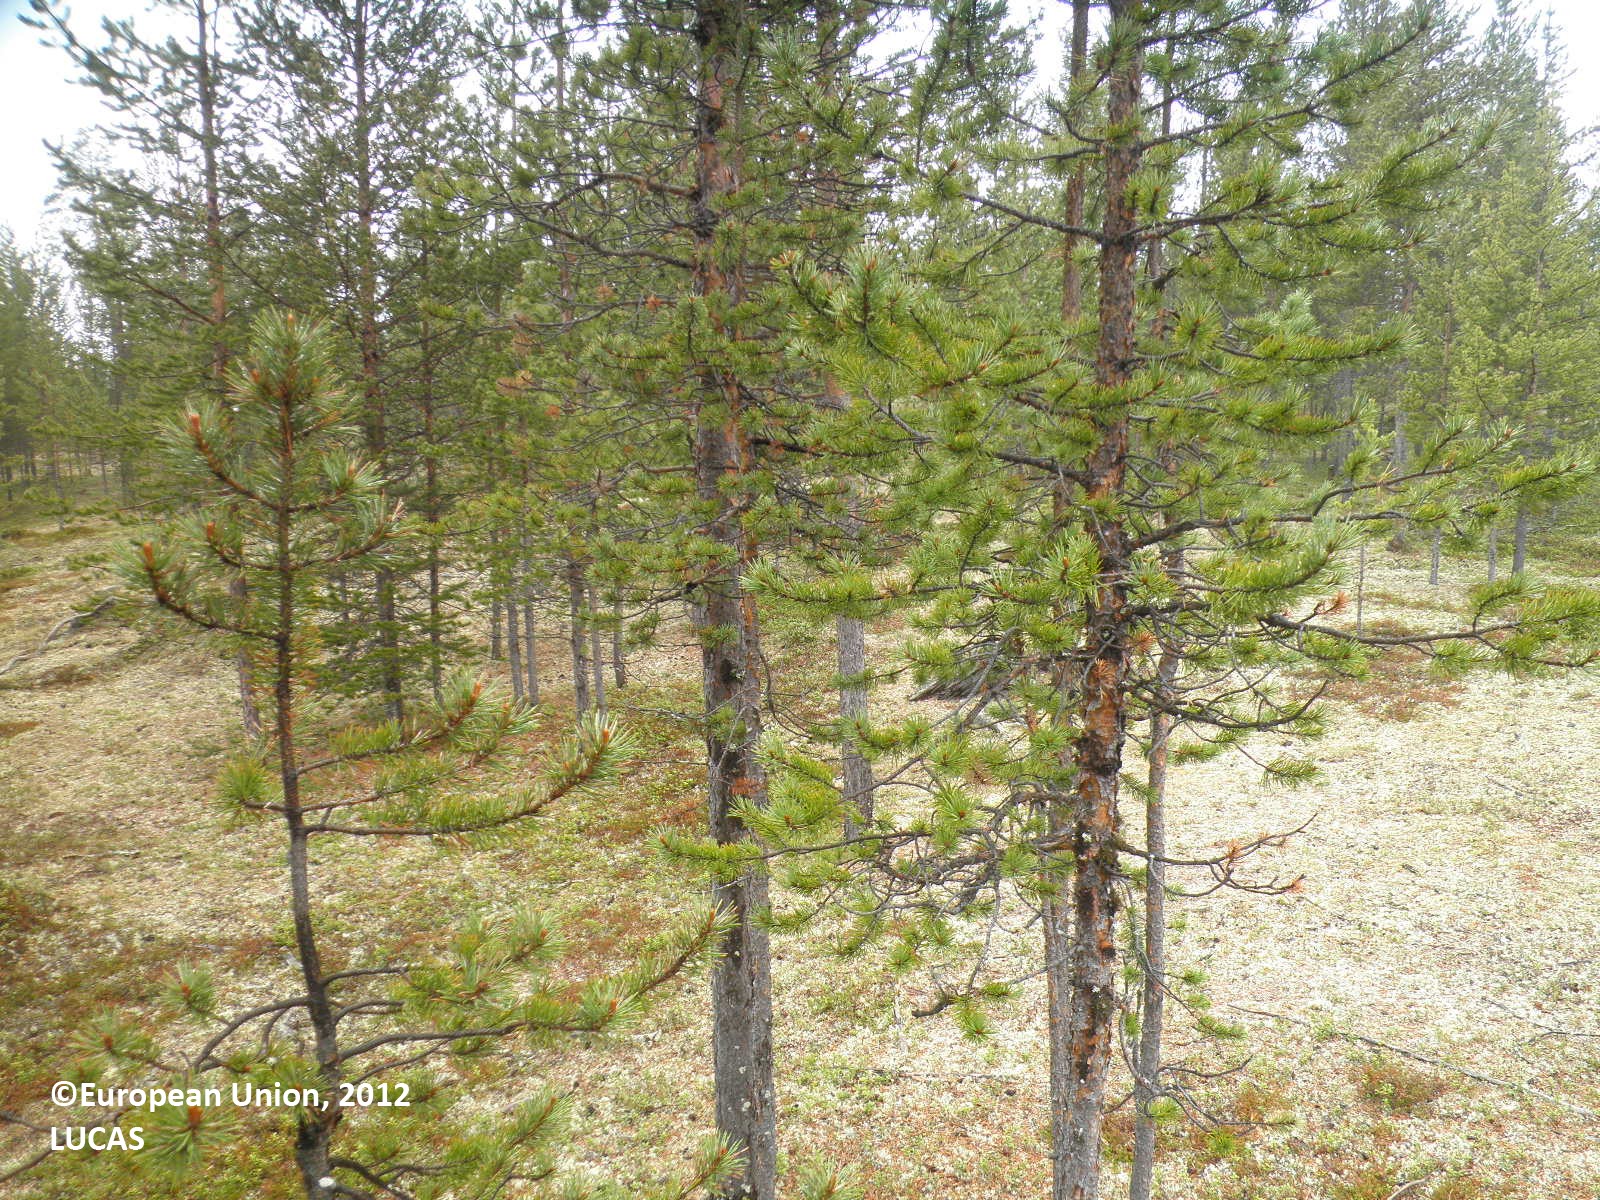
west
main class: Woodland
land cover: Pine dominated coniferous woodland
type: boreal forest
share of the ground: > 75 %
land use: Forestry
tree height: > 5 m
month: June
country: FI
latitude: 69.0768
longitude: 27.0441
